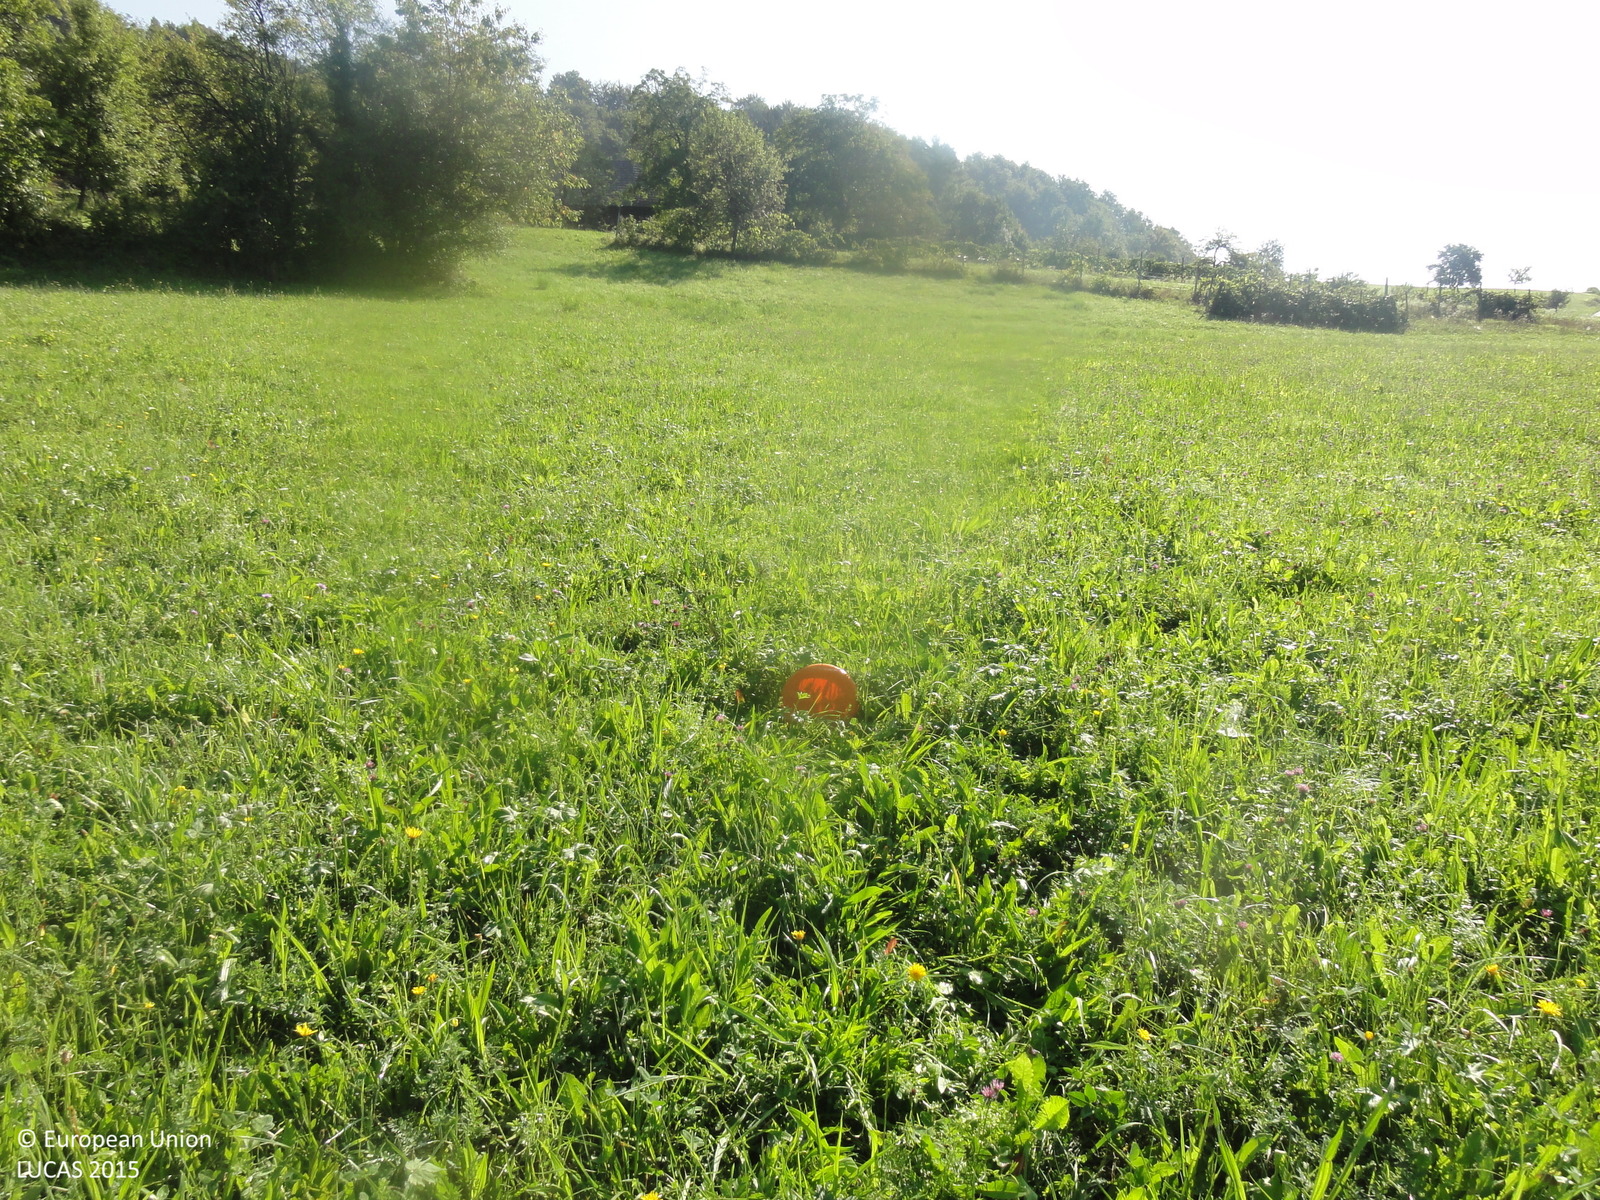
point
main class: Grassland
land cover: Grassland without tree/shrub cover
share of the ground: > 75 %
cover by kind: herbaceous plants 100 %
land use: Agriculture (excluding fallow land and kitchen gardens)
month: August
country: SI
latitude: 46.1146
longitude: 15.2377
